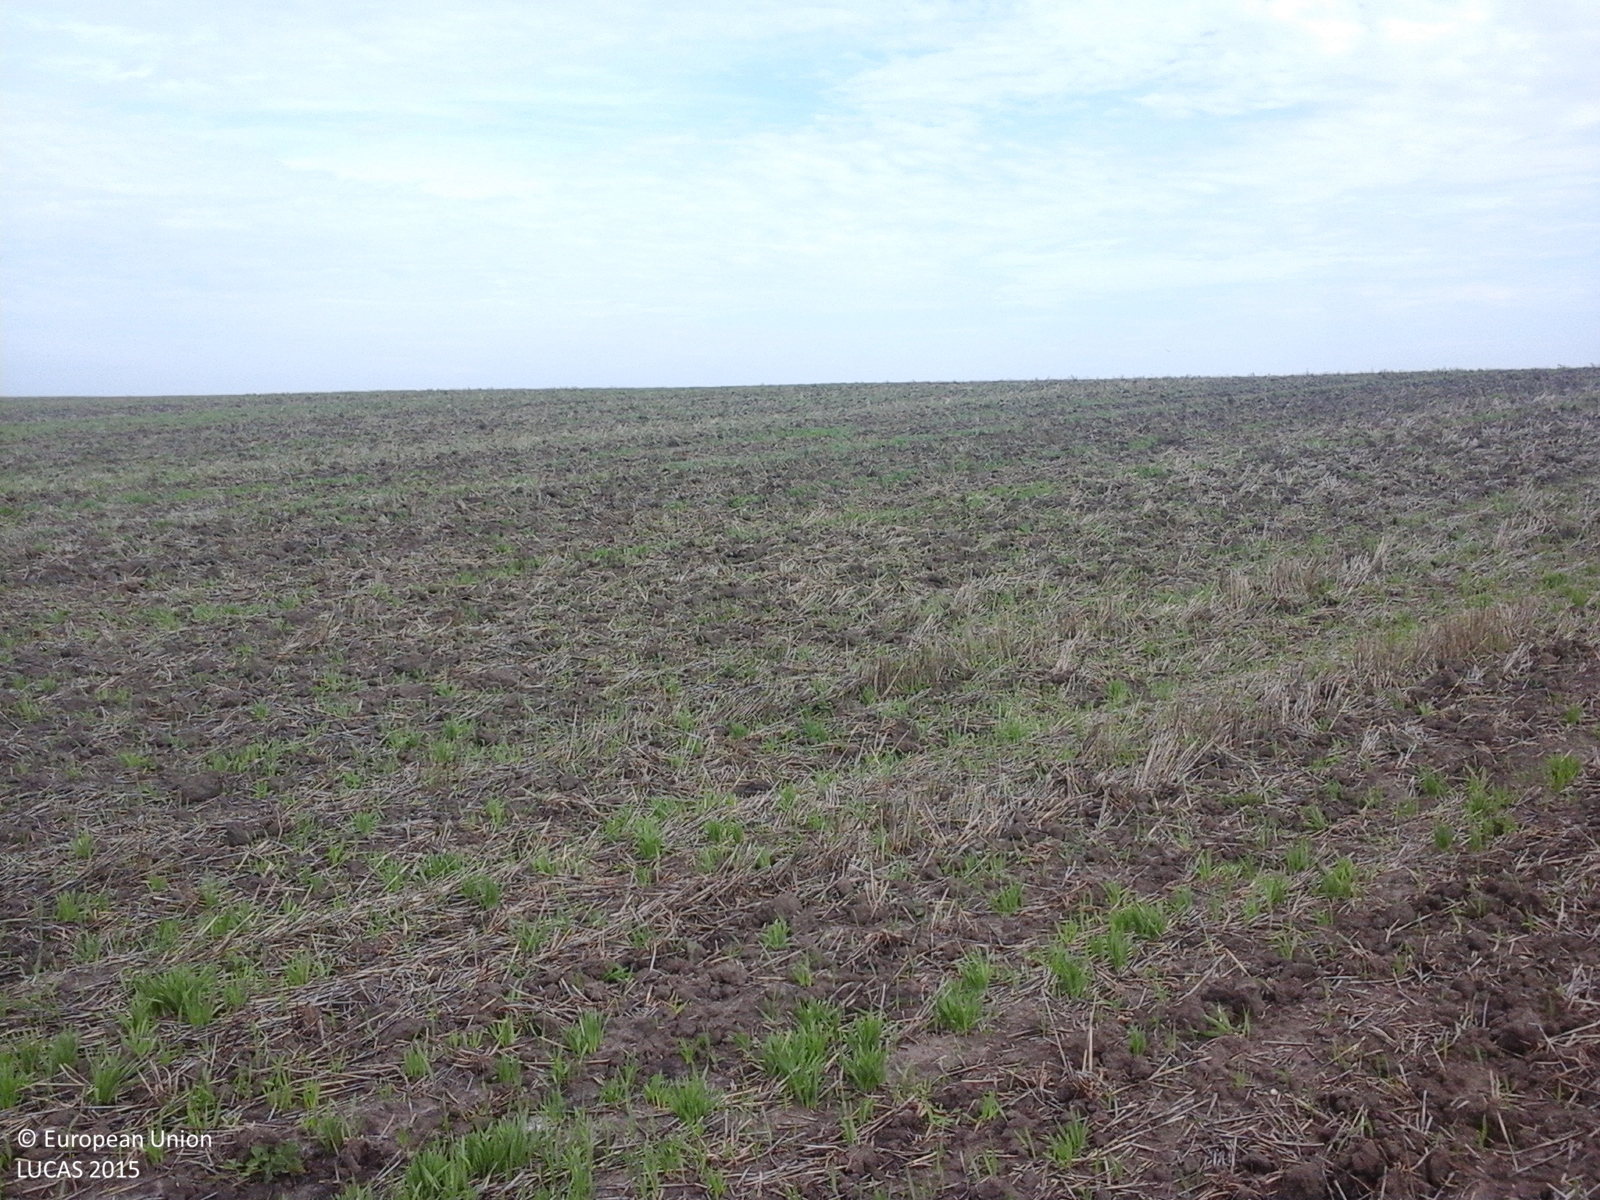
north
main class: Cropland
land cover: Common wheat
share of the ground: < 10 %
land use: Agriculture (excluding fallow land and kitchen gardens)
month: August
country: RO
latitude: 46.2570
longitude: 21.4912
